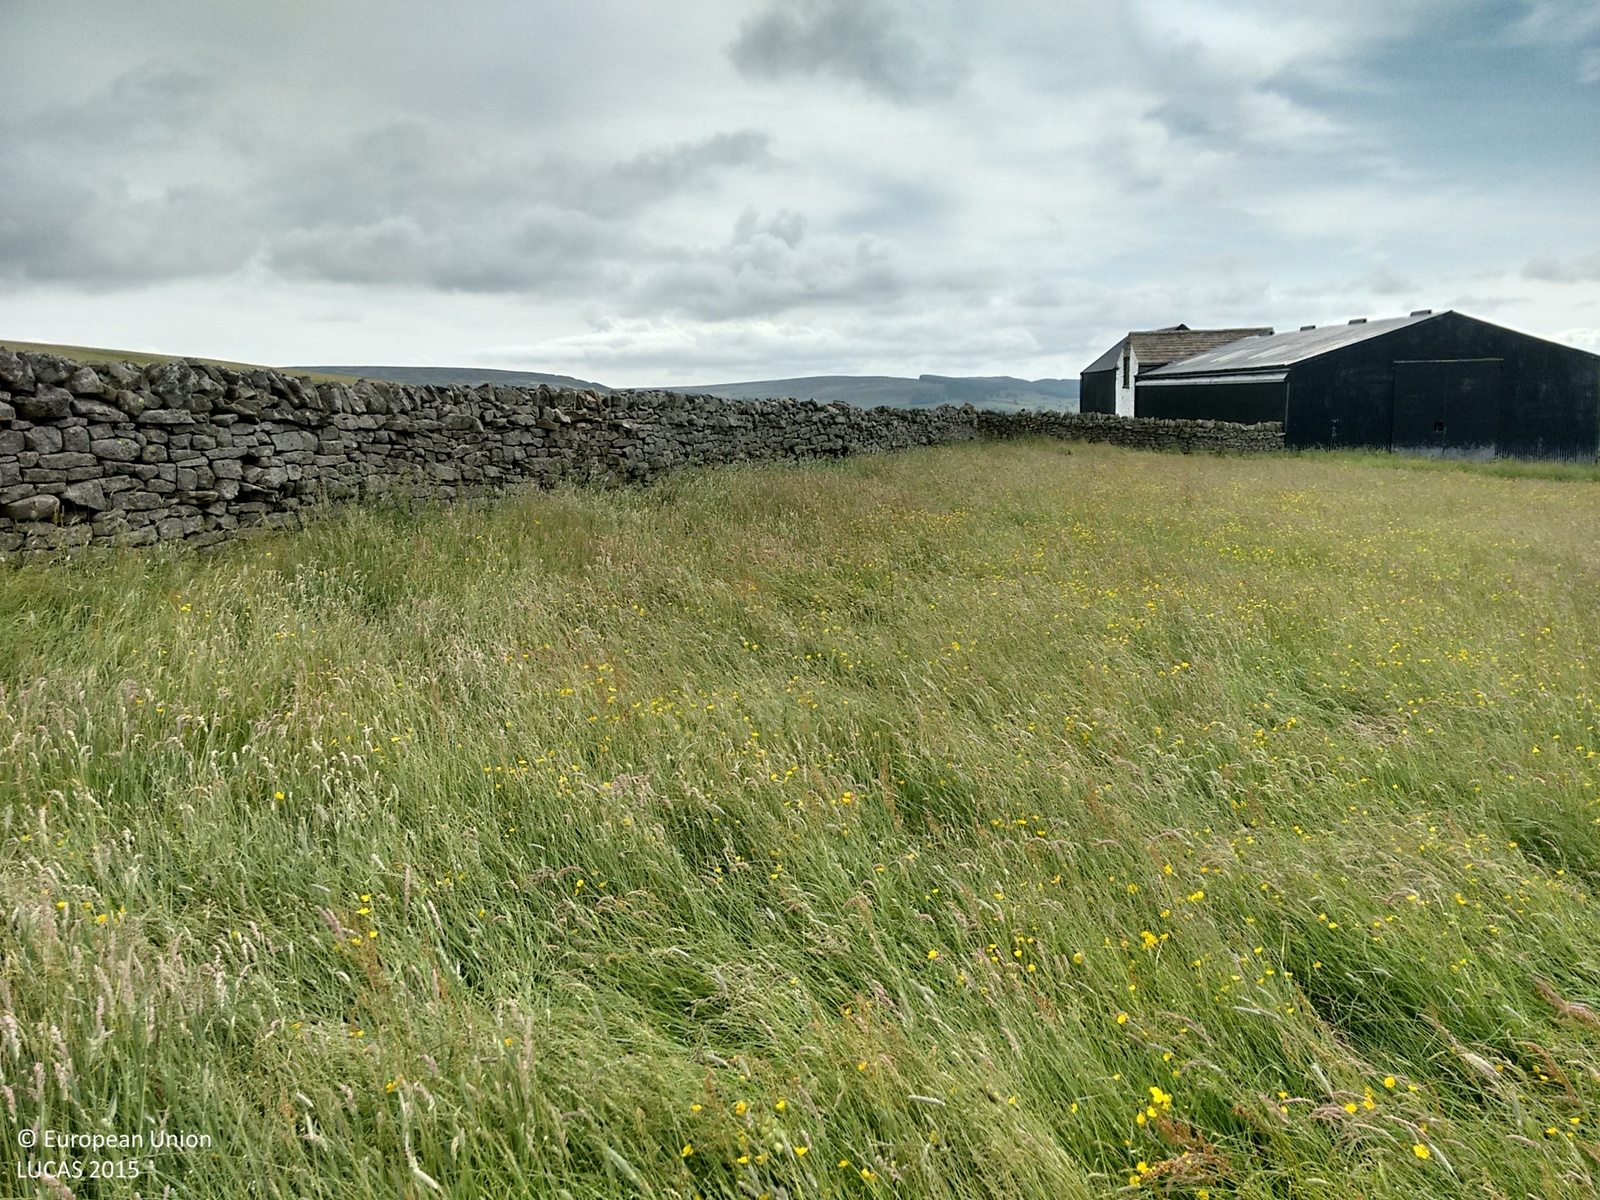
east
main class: Grassland
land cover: Grassland without tree/shrub cover
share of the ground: > 75 %
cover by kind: herbaceous plants 100 %
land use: Agriculture (excluding fallow land and kitchen gardens)
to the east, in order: Grassland without tree/shrub cover; Dry stone walls; Grassland without tree/shrub cover; Dry stone walls; Grassland without tree/shrub cover; Shrubland without tree cover; Grassland without tree/shrub cover
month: July
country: GB
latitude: 54.6335
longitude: -2.0627
